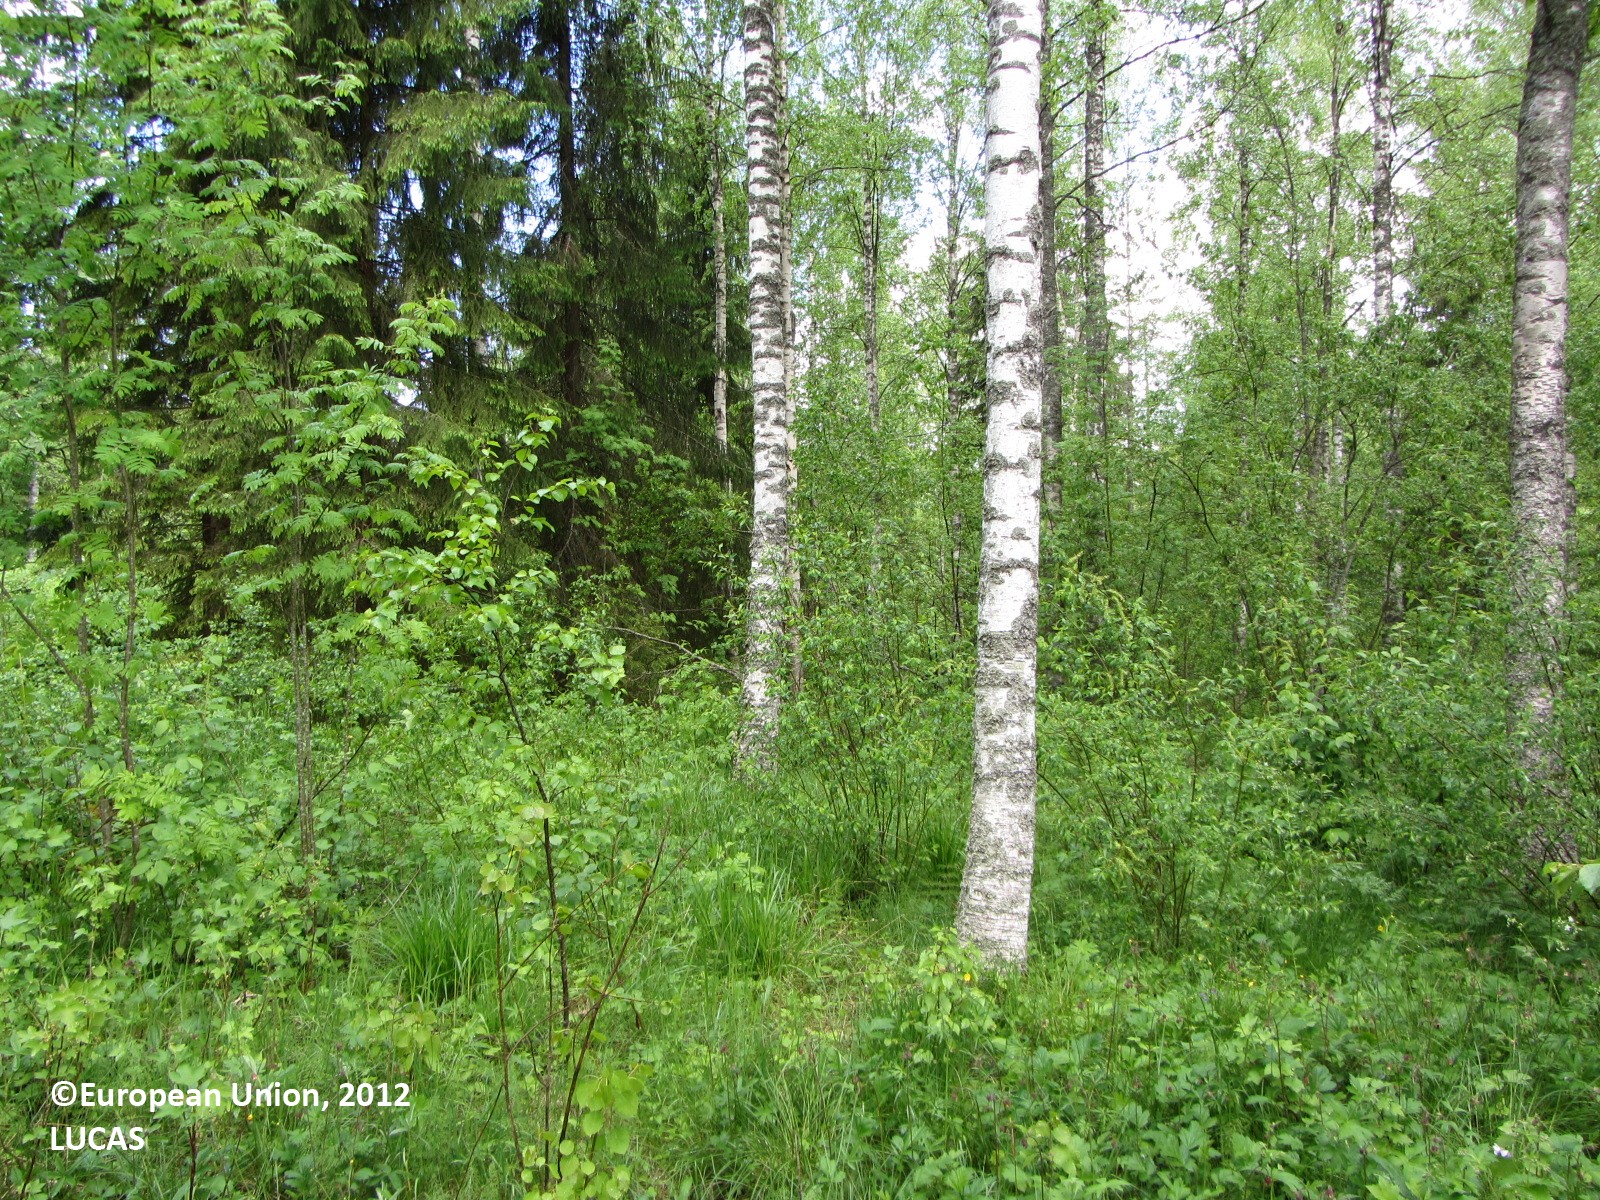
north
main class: Woodland
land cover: Broadleaved woodland
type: hemiboreal forest and nemoral coniferous forest and mixed broadleaved-coniferous forest
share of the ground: 50 - 75 %
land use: Forestry
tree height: > 5 m
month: June
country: FI
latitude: 61.8674
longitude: 24.8751
